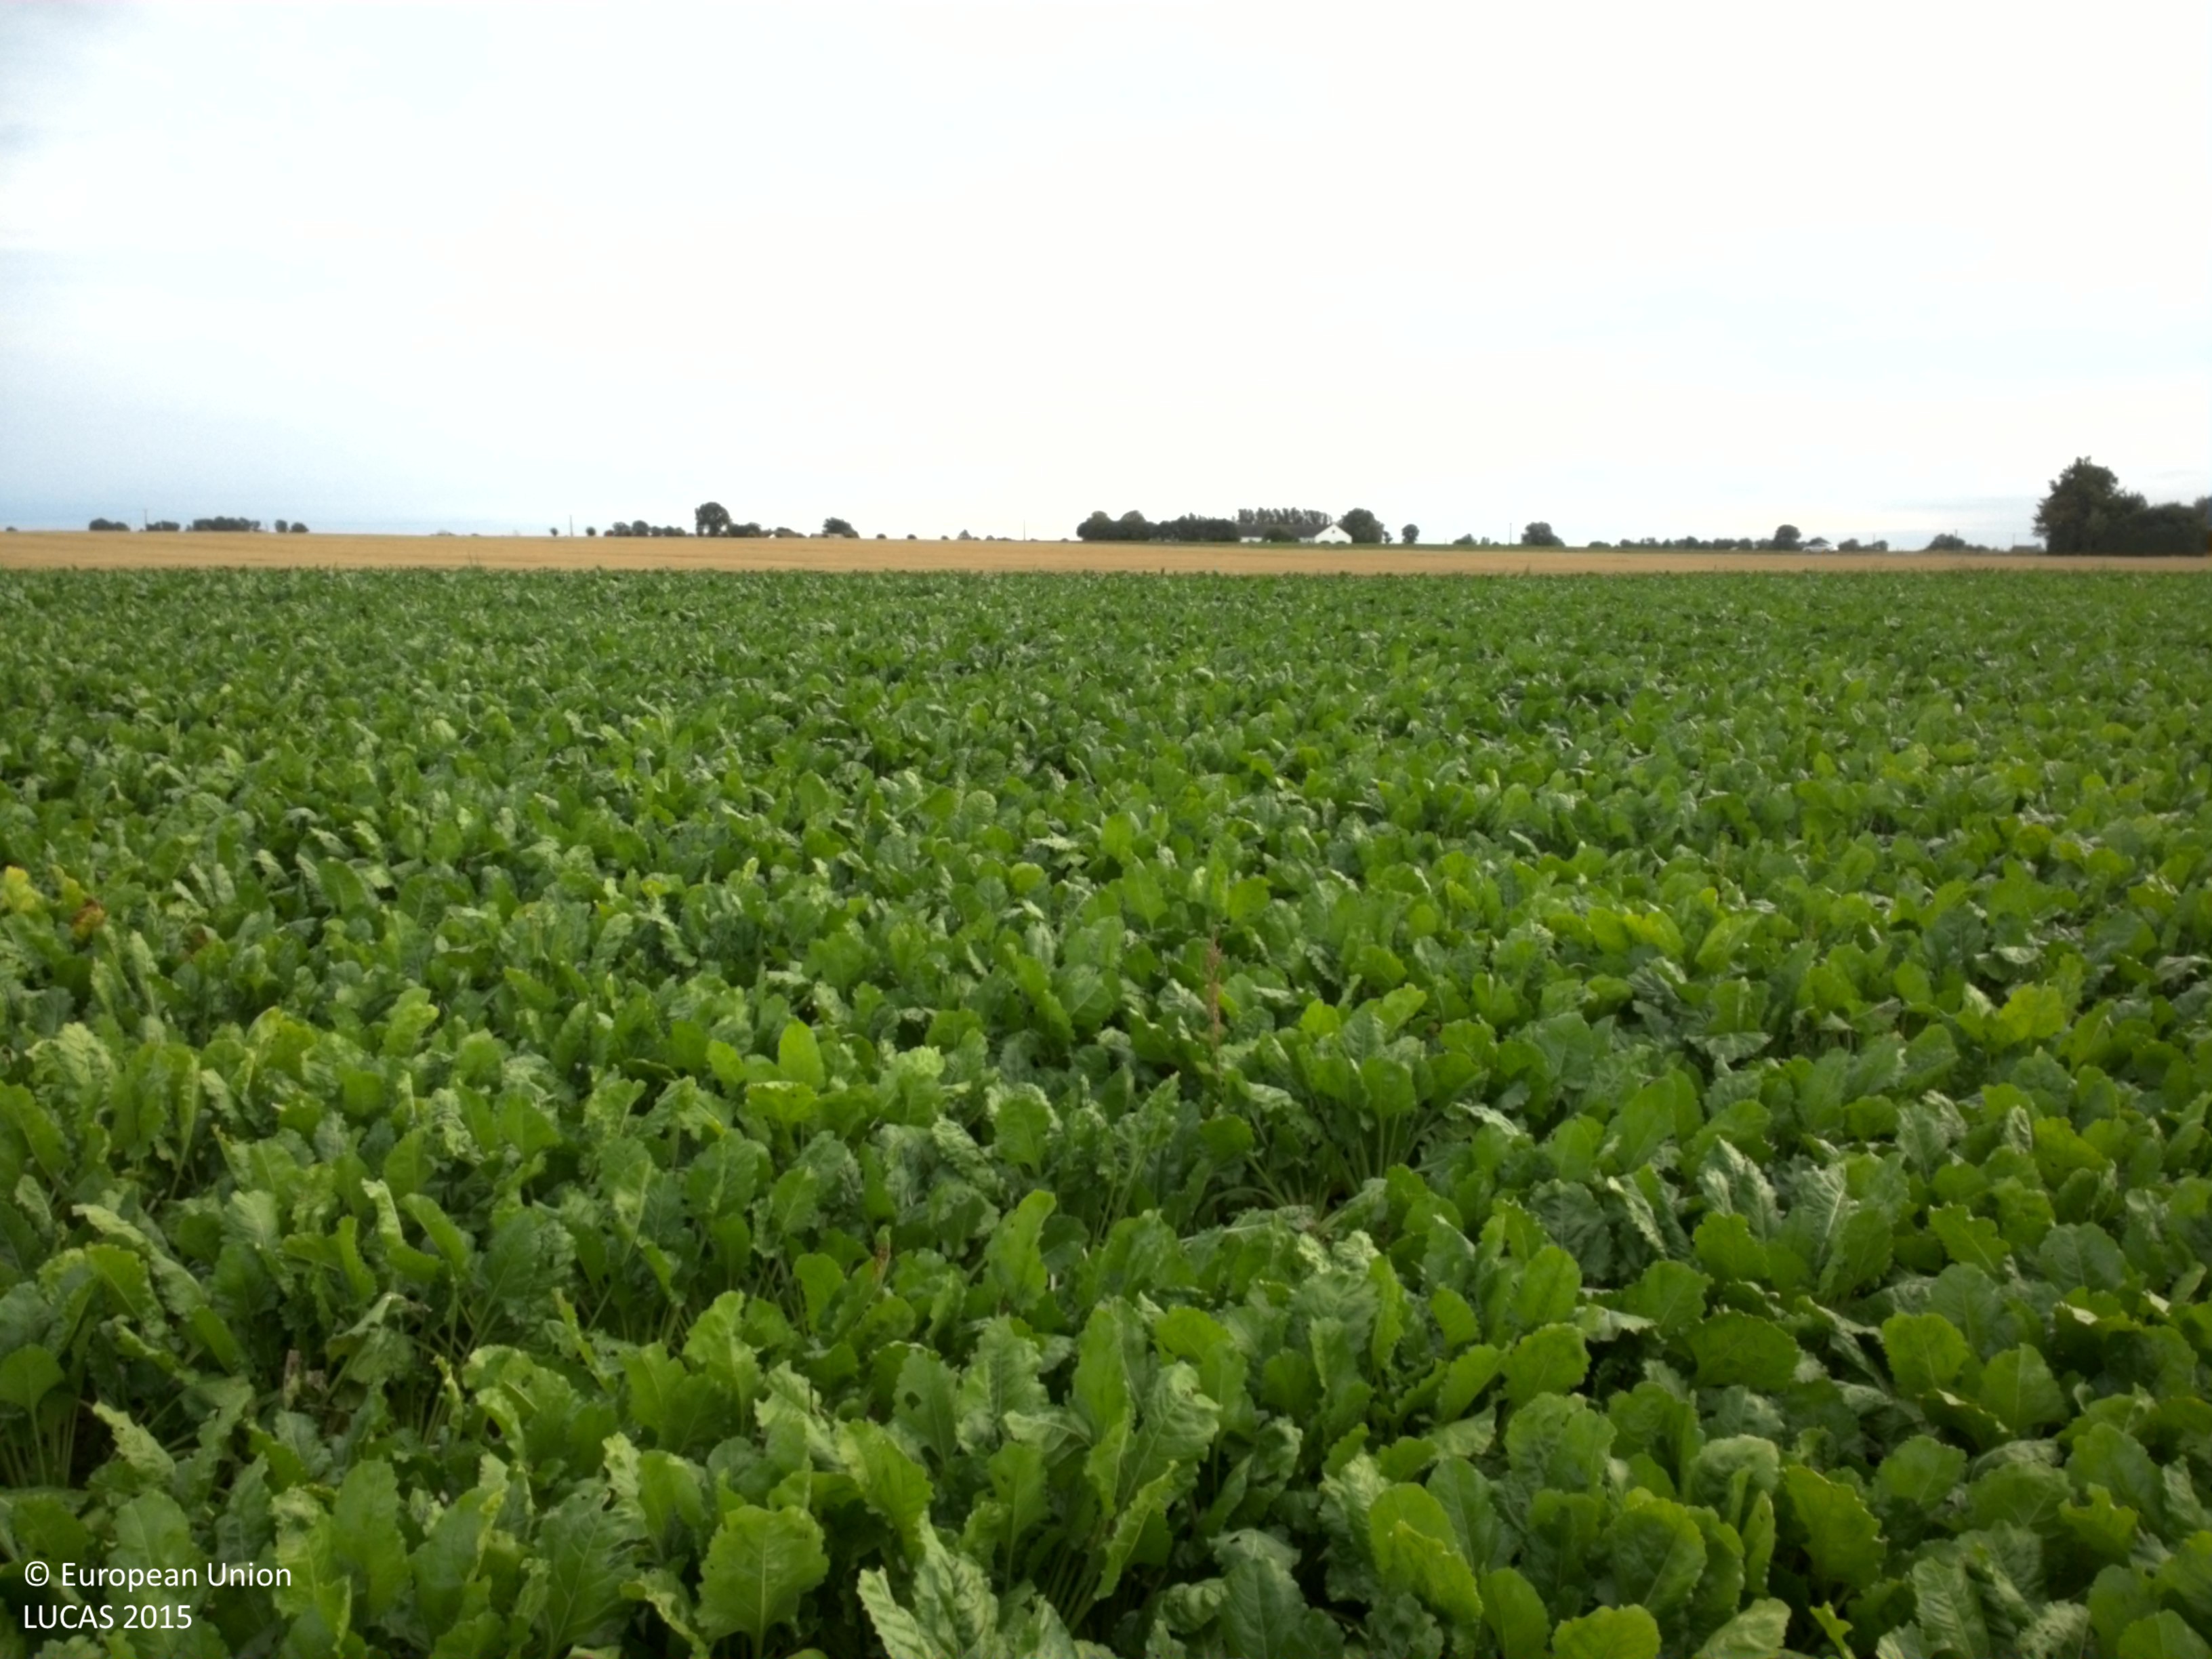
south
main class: Cropland
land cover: Sugar beet
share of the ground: > 75 %
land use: Agriculture (excluding fallow land and kitchen gardens)
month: September
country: SE
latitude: 55.4534
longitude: 14.1889
